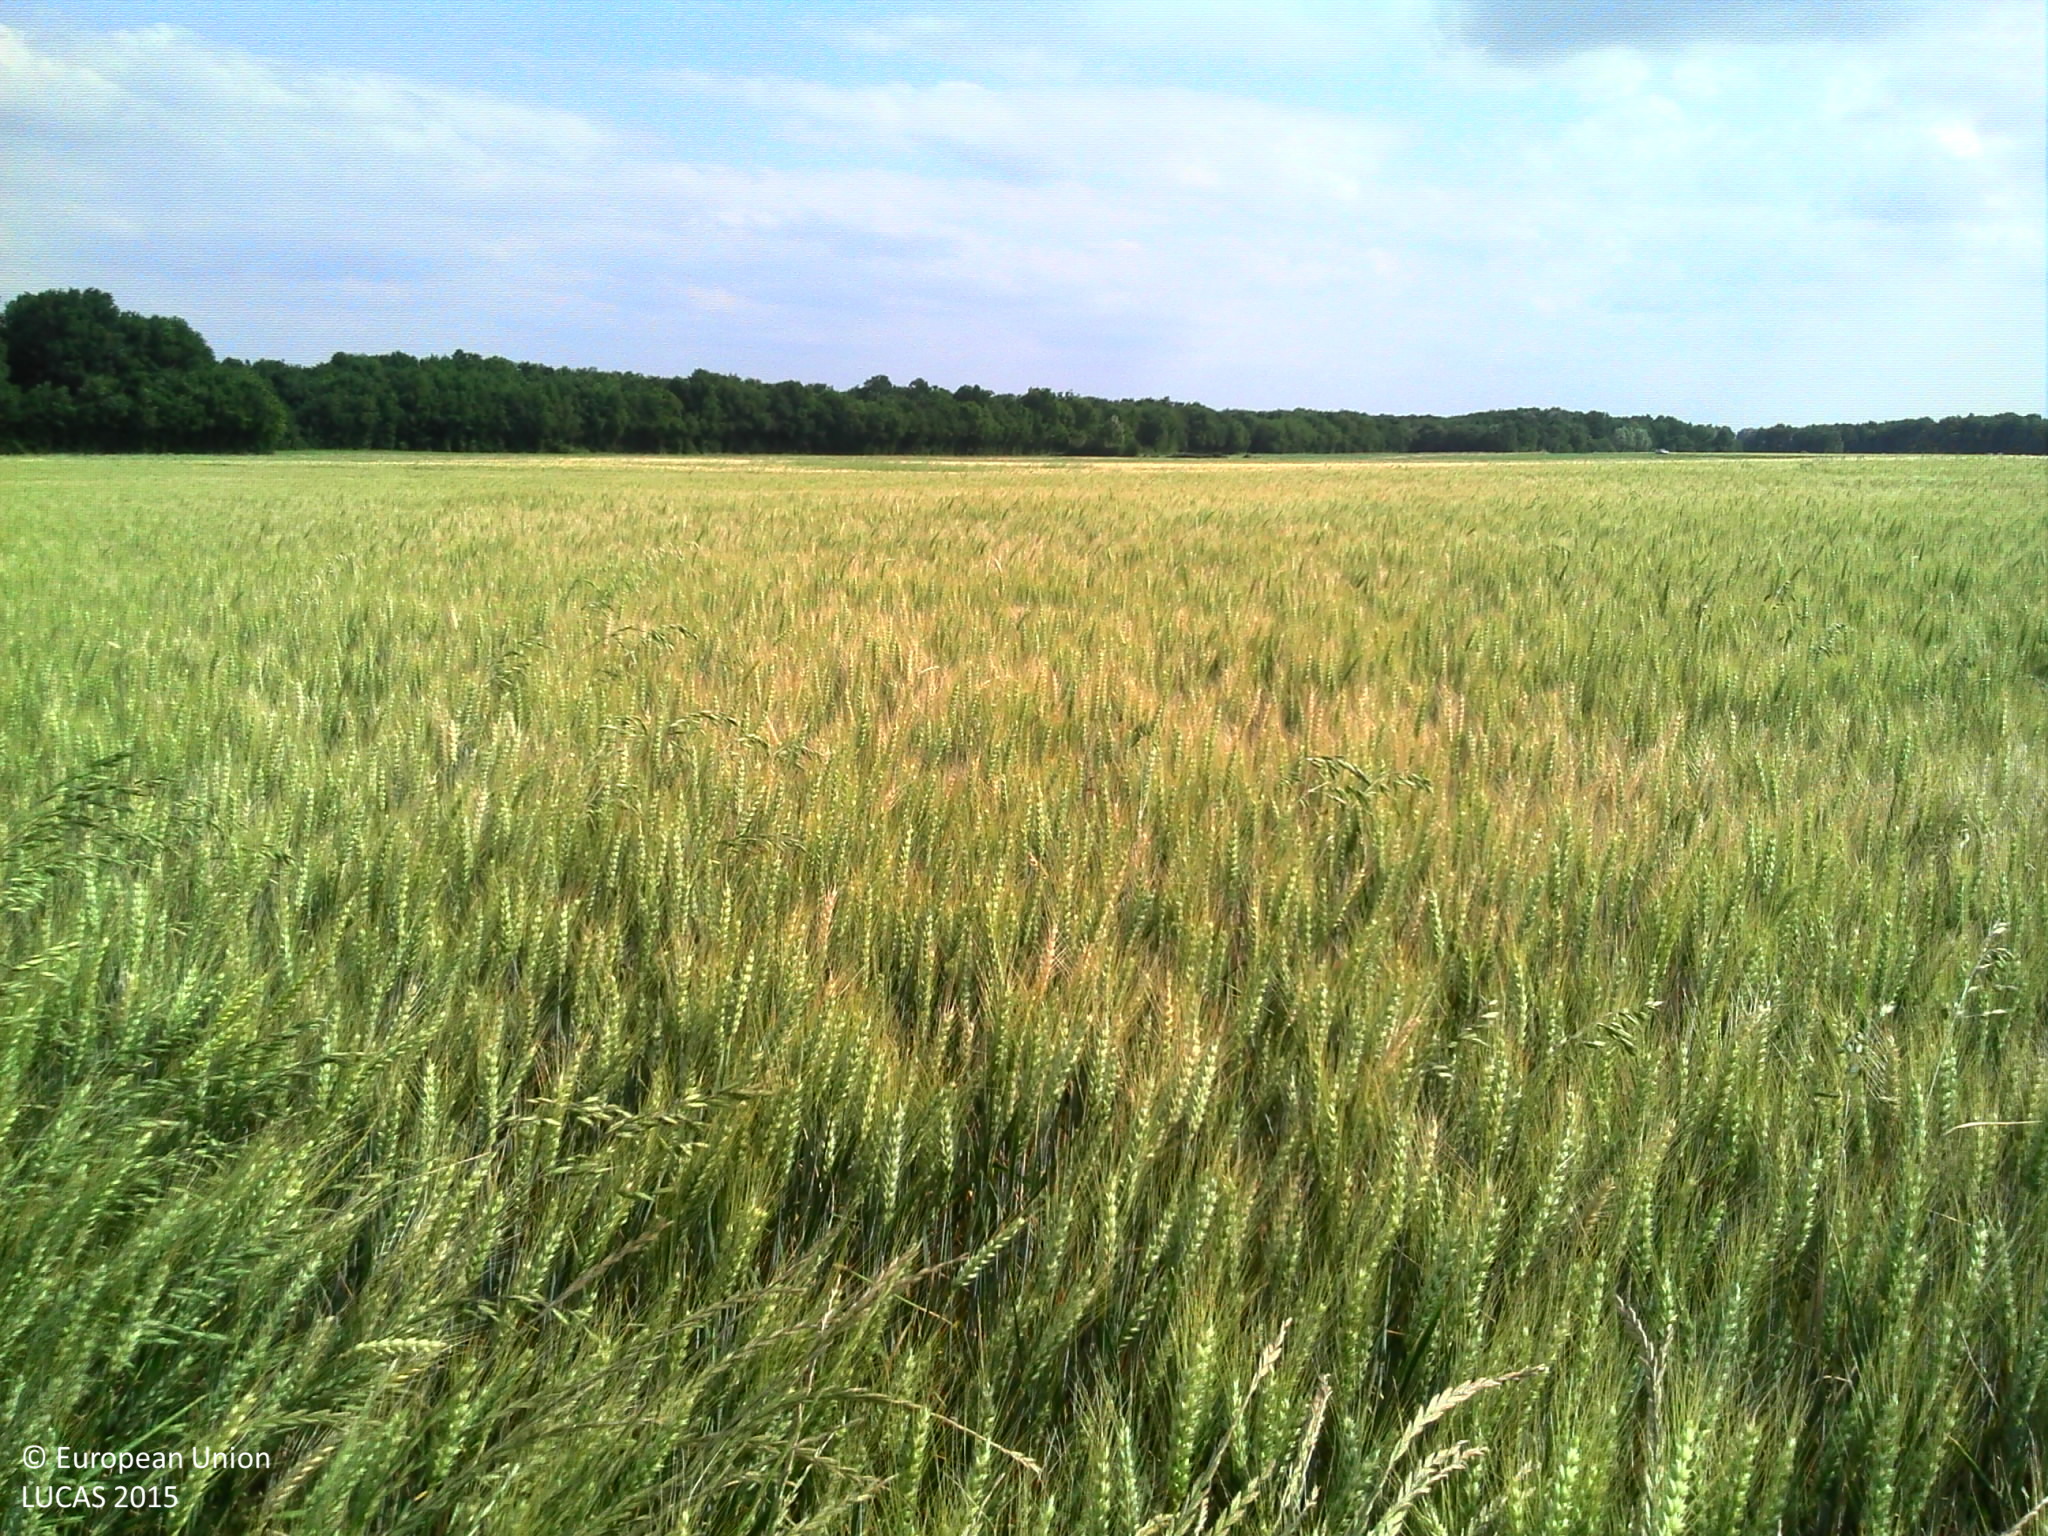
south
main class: Cropland
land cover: Common wheat
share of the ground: > 75 %
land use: Agriculture (excluding fallow land and kitchen gardens)
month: June
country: FR
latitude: 46.8595
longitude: 0.1800
